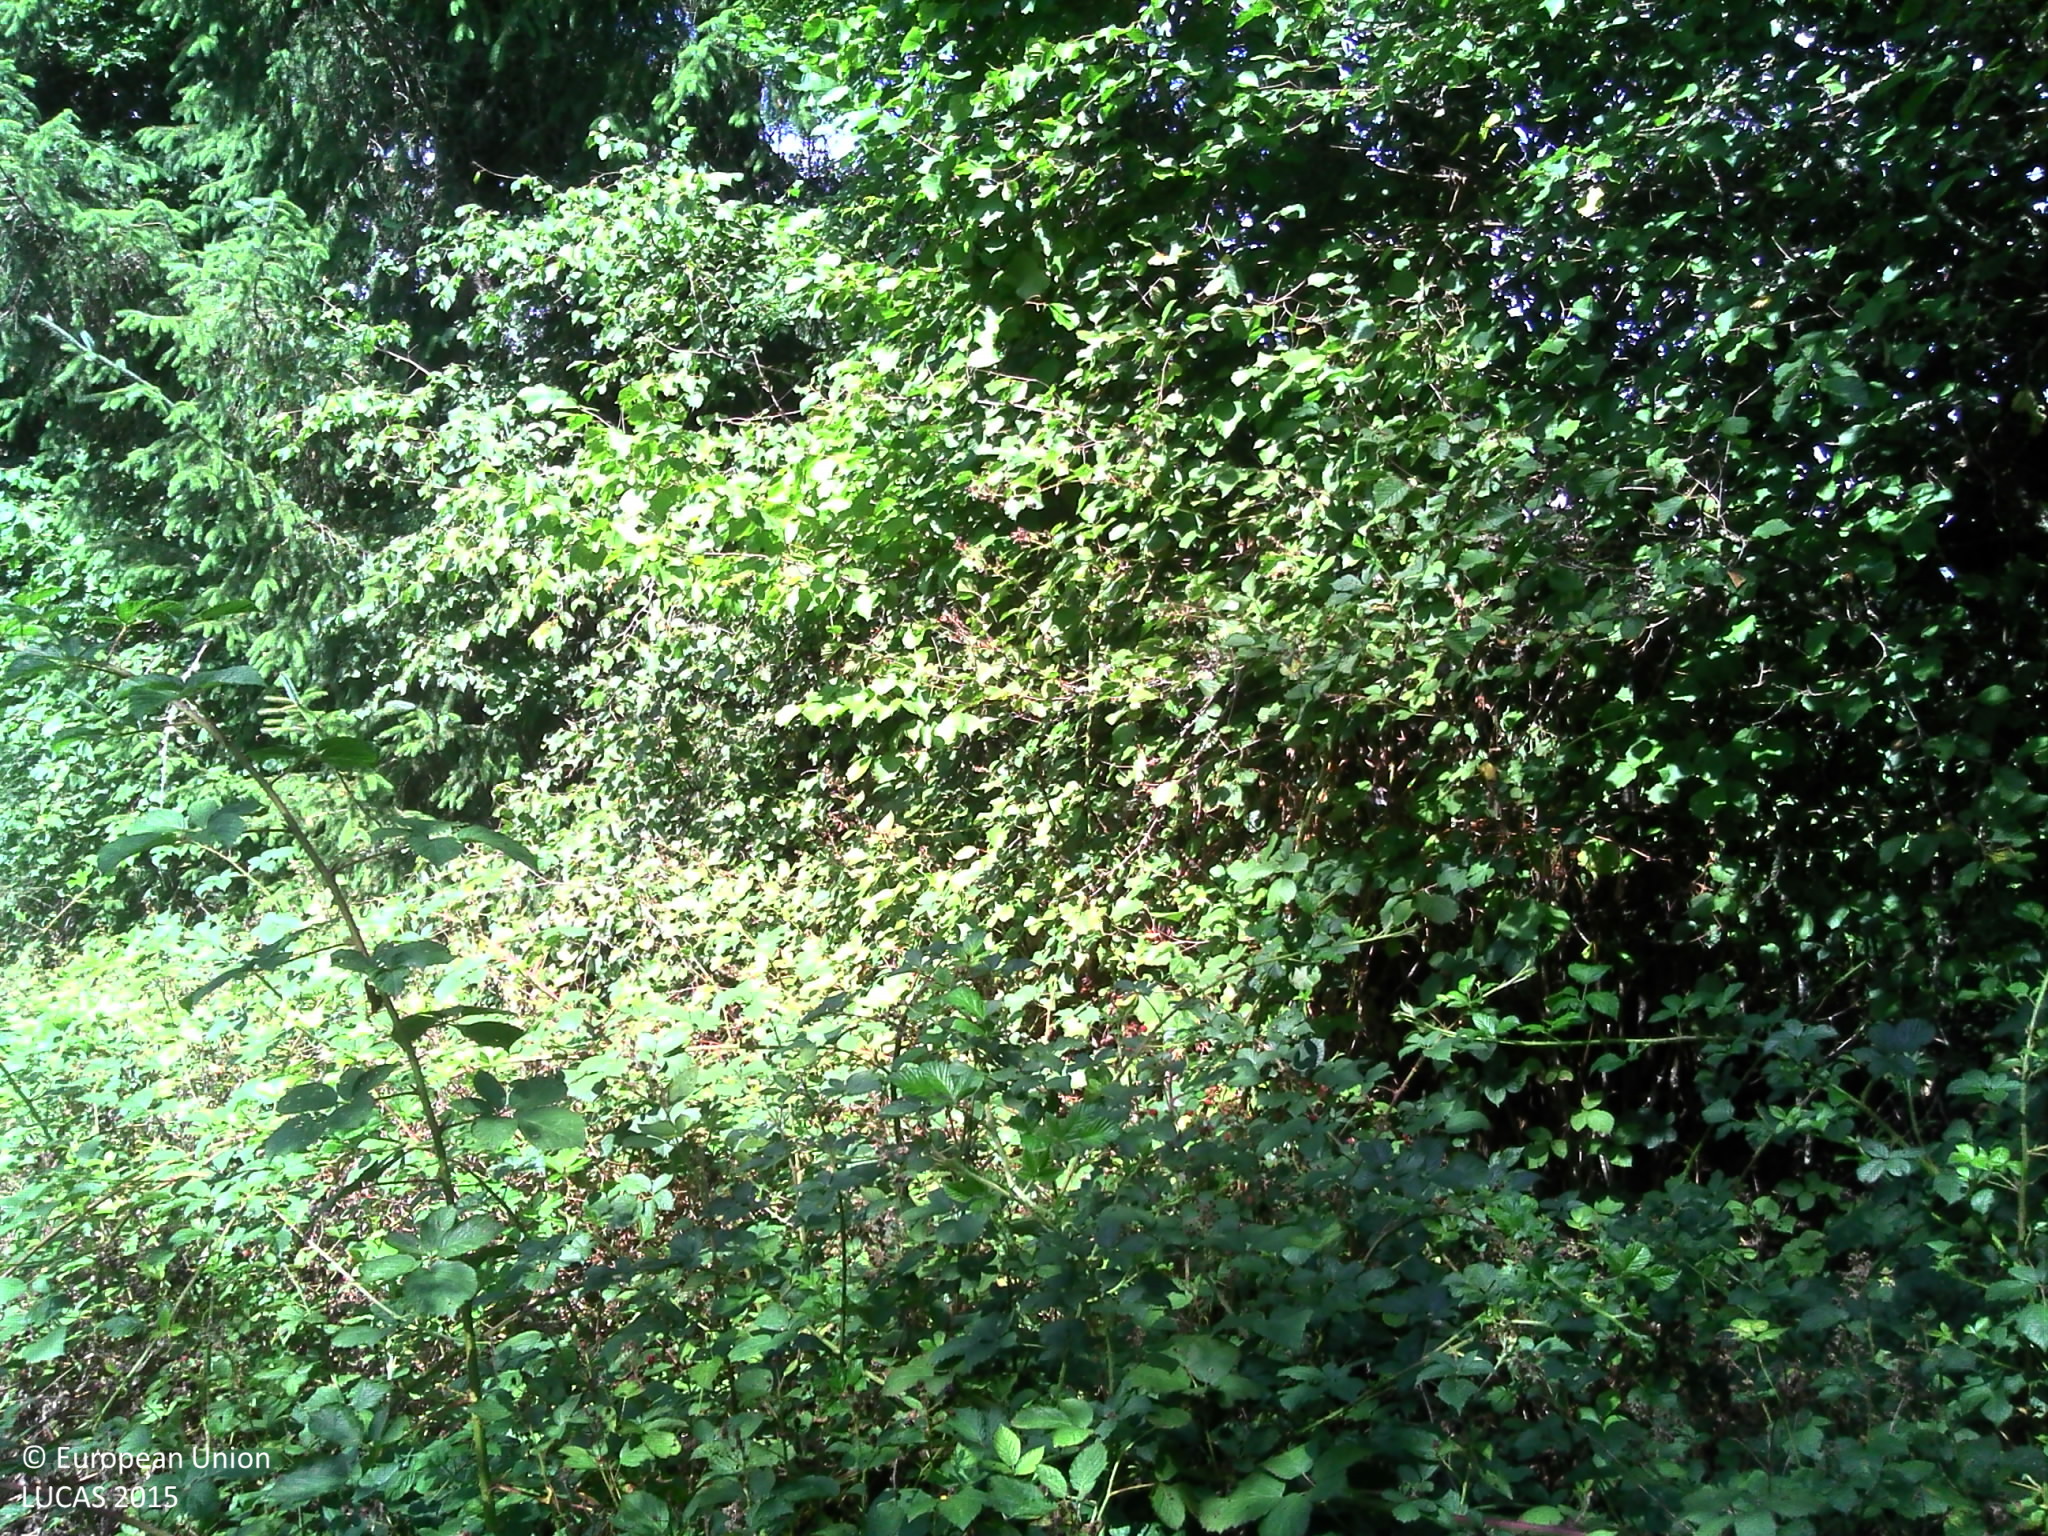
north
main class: Woodland
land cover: Spruce dominated mixed woodland
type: mesophytic deciduous forest
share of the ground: > 75 %
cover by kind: broadleaved forest trees 60 %, coniferous forest trees 25 %, shrubs 10 %, herbaceous plants 5 %
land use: Semi-natural and natural areas not in use
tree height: > 5 m
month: August
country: FR
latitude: 45.7889
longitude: 2.3688
